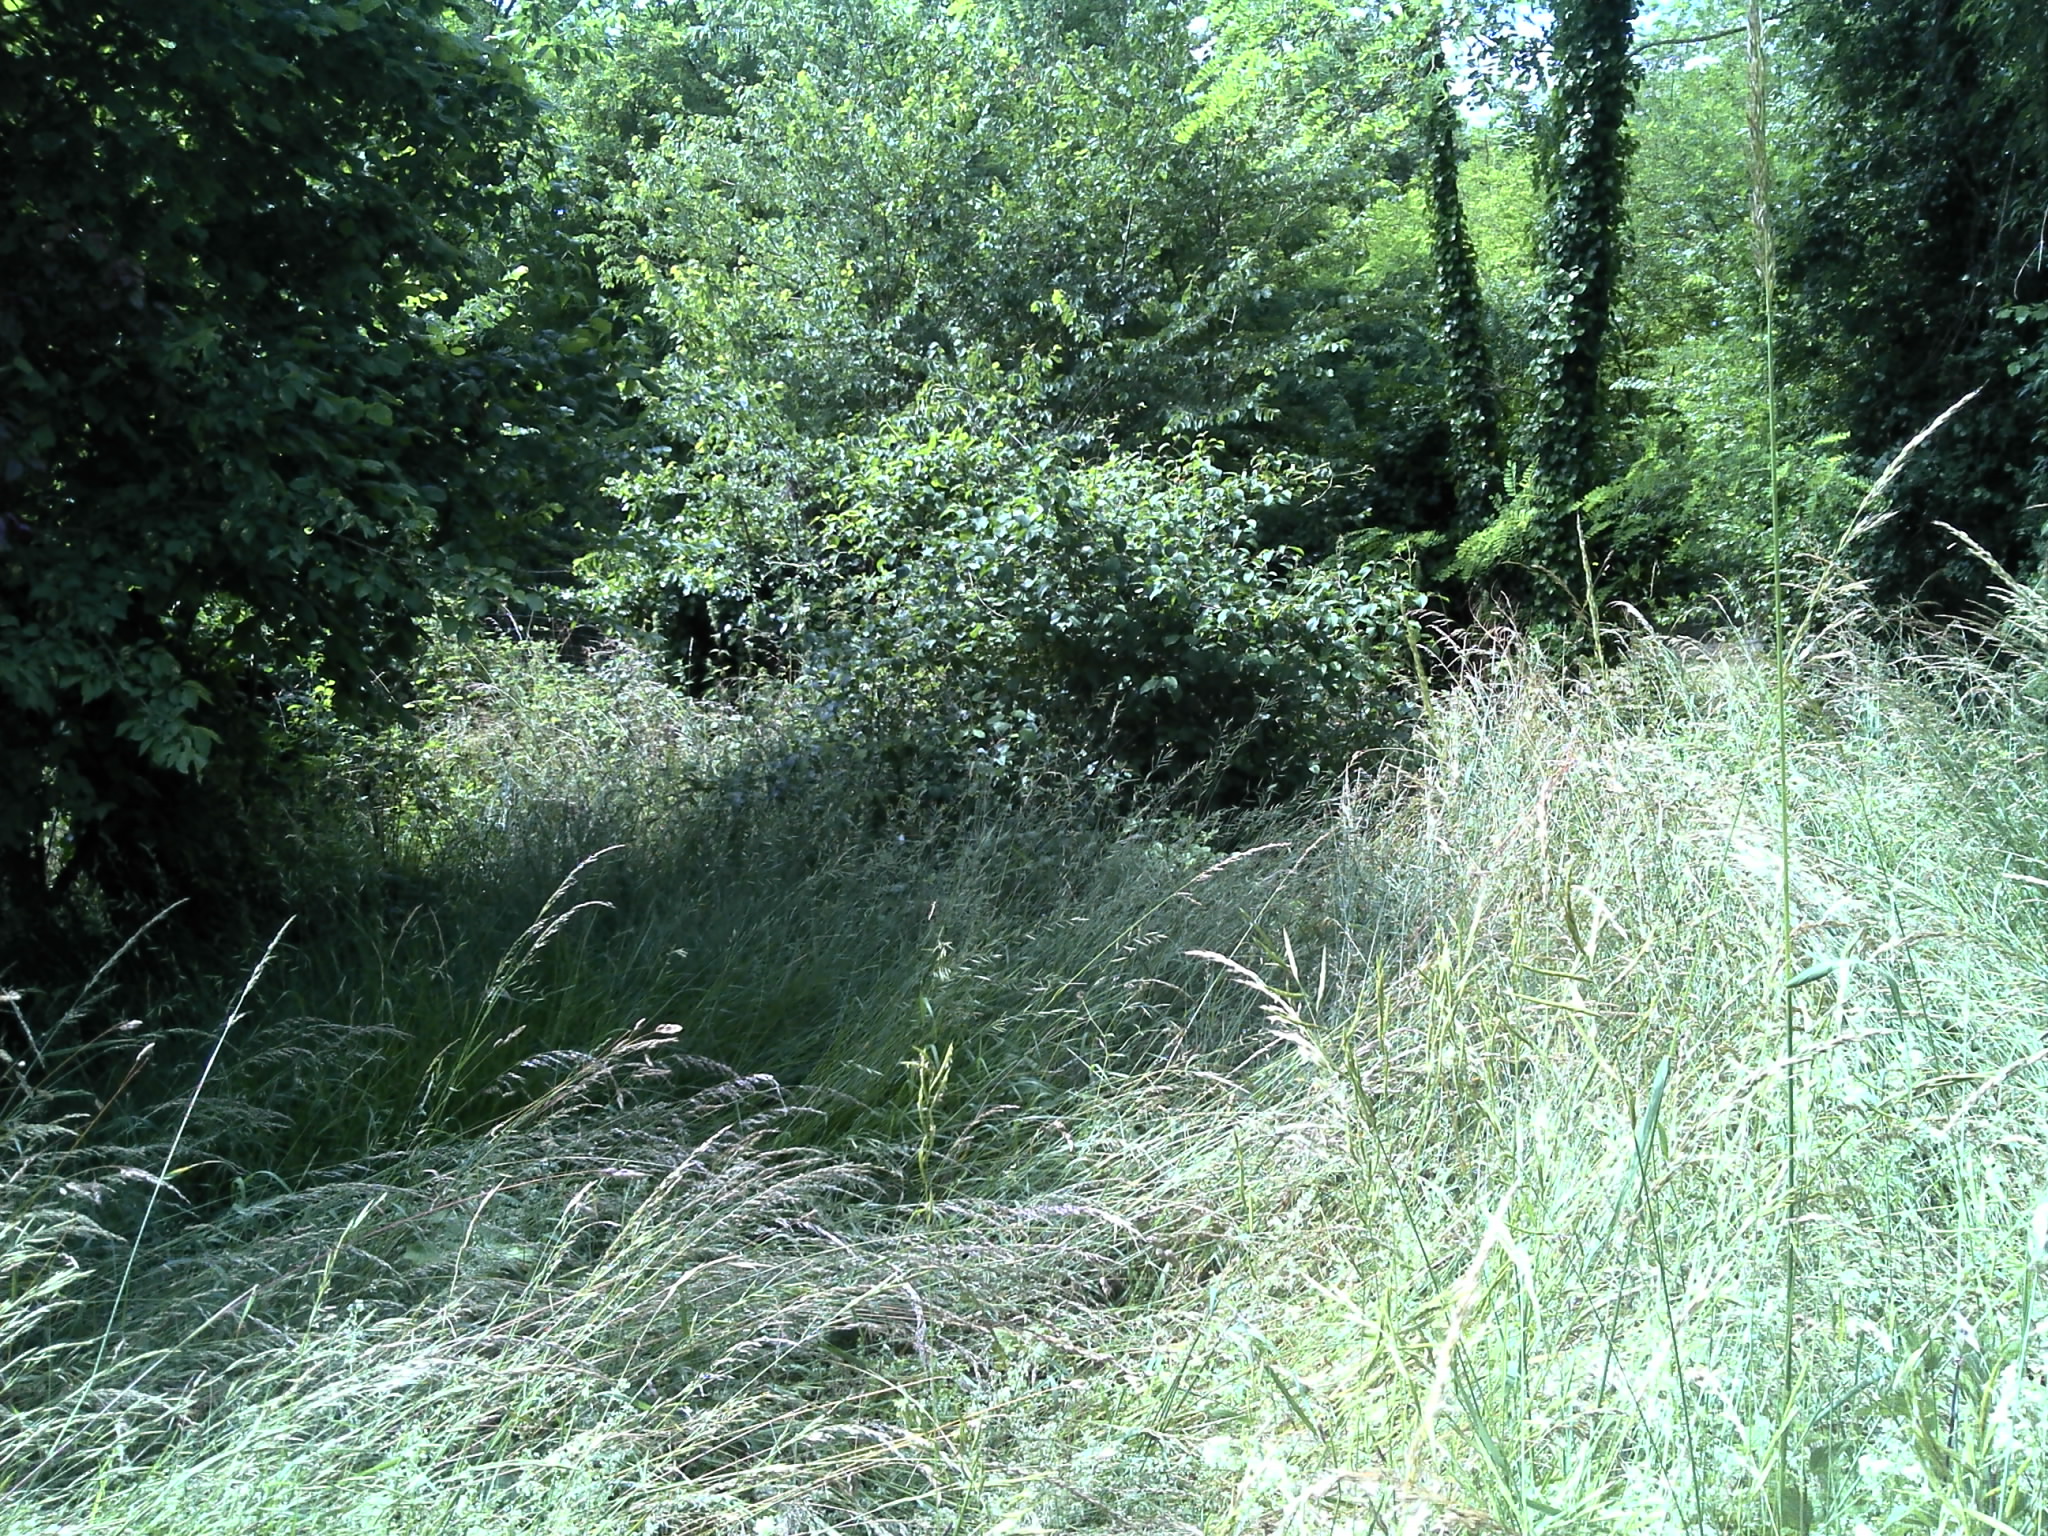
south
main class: Grassland
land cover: Grassland with sparse tree/shrub cover
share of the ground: > 75 %
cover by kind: herbaceous plants 90 %, broadleaved forest trees 5 %, shrubs 5 %
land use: Semi-natural and natural areas not in use
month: June
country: FR
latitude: 47.1775
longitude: 1.5827
